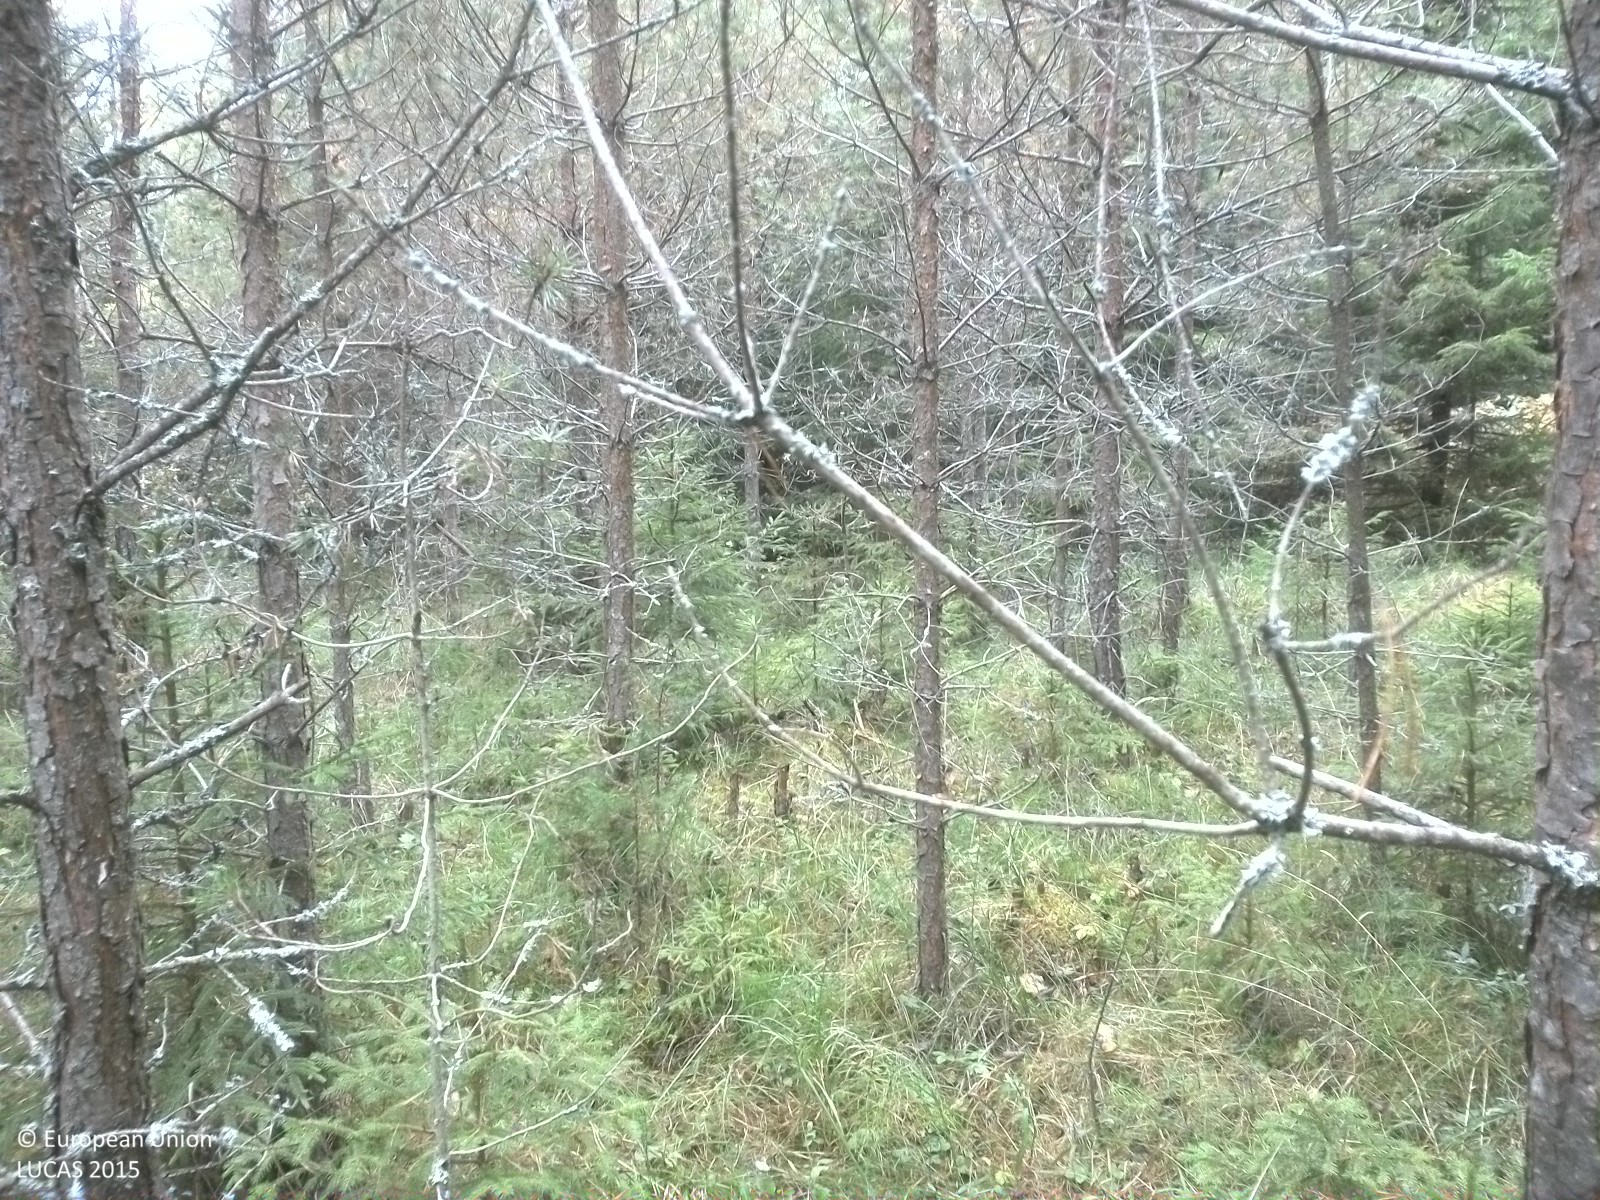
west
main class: Woodland
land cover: Pine dominated coniferous woodland
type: boreal forest
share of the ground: 50 - 75 %
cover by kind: coniferous forest trees 50 %, herbaceous plants 40 %, lichens and mosses 10 %
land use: Forestry
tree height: < 5 m
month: September
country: SE
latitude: 58.6542
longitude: 16.9425
